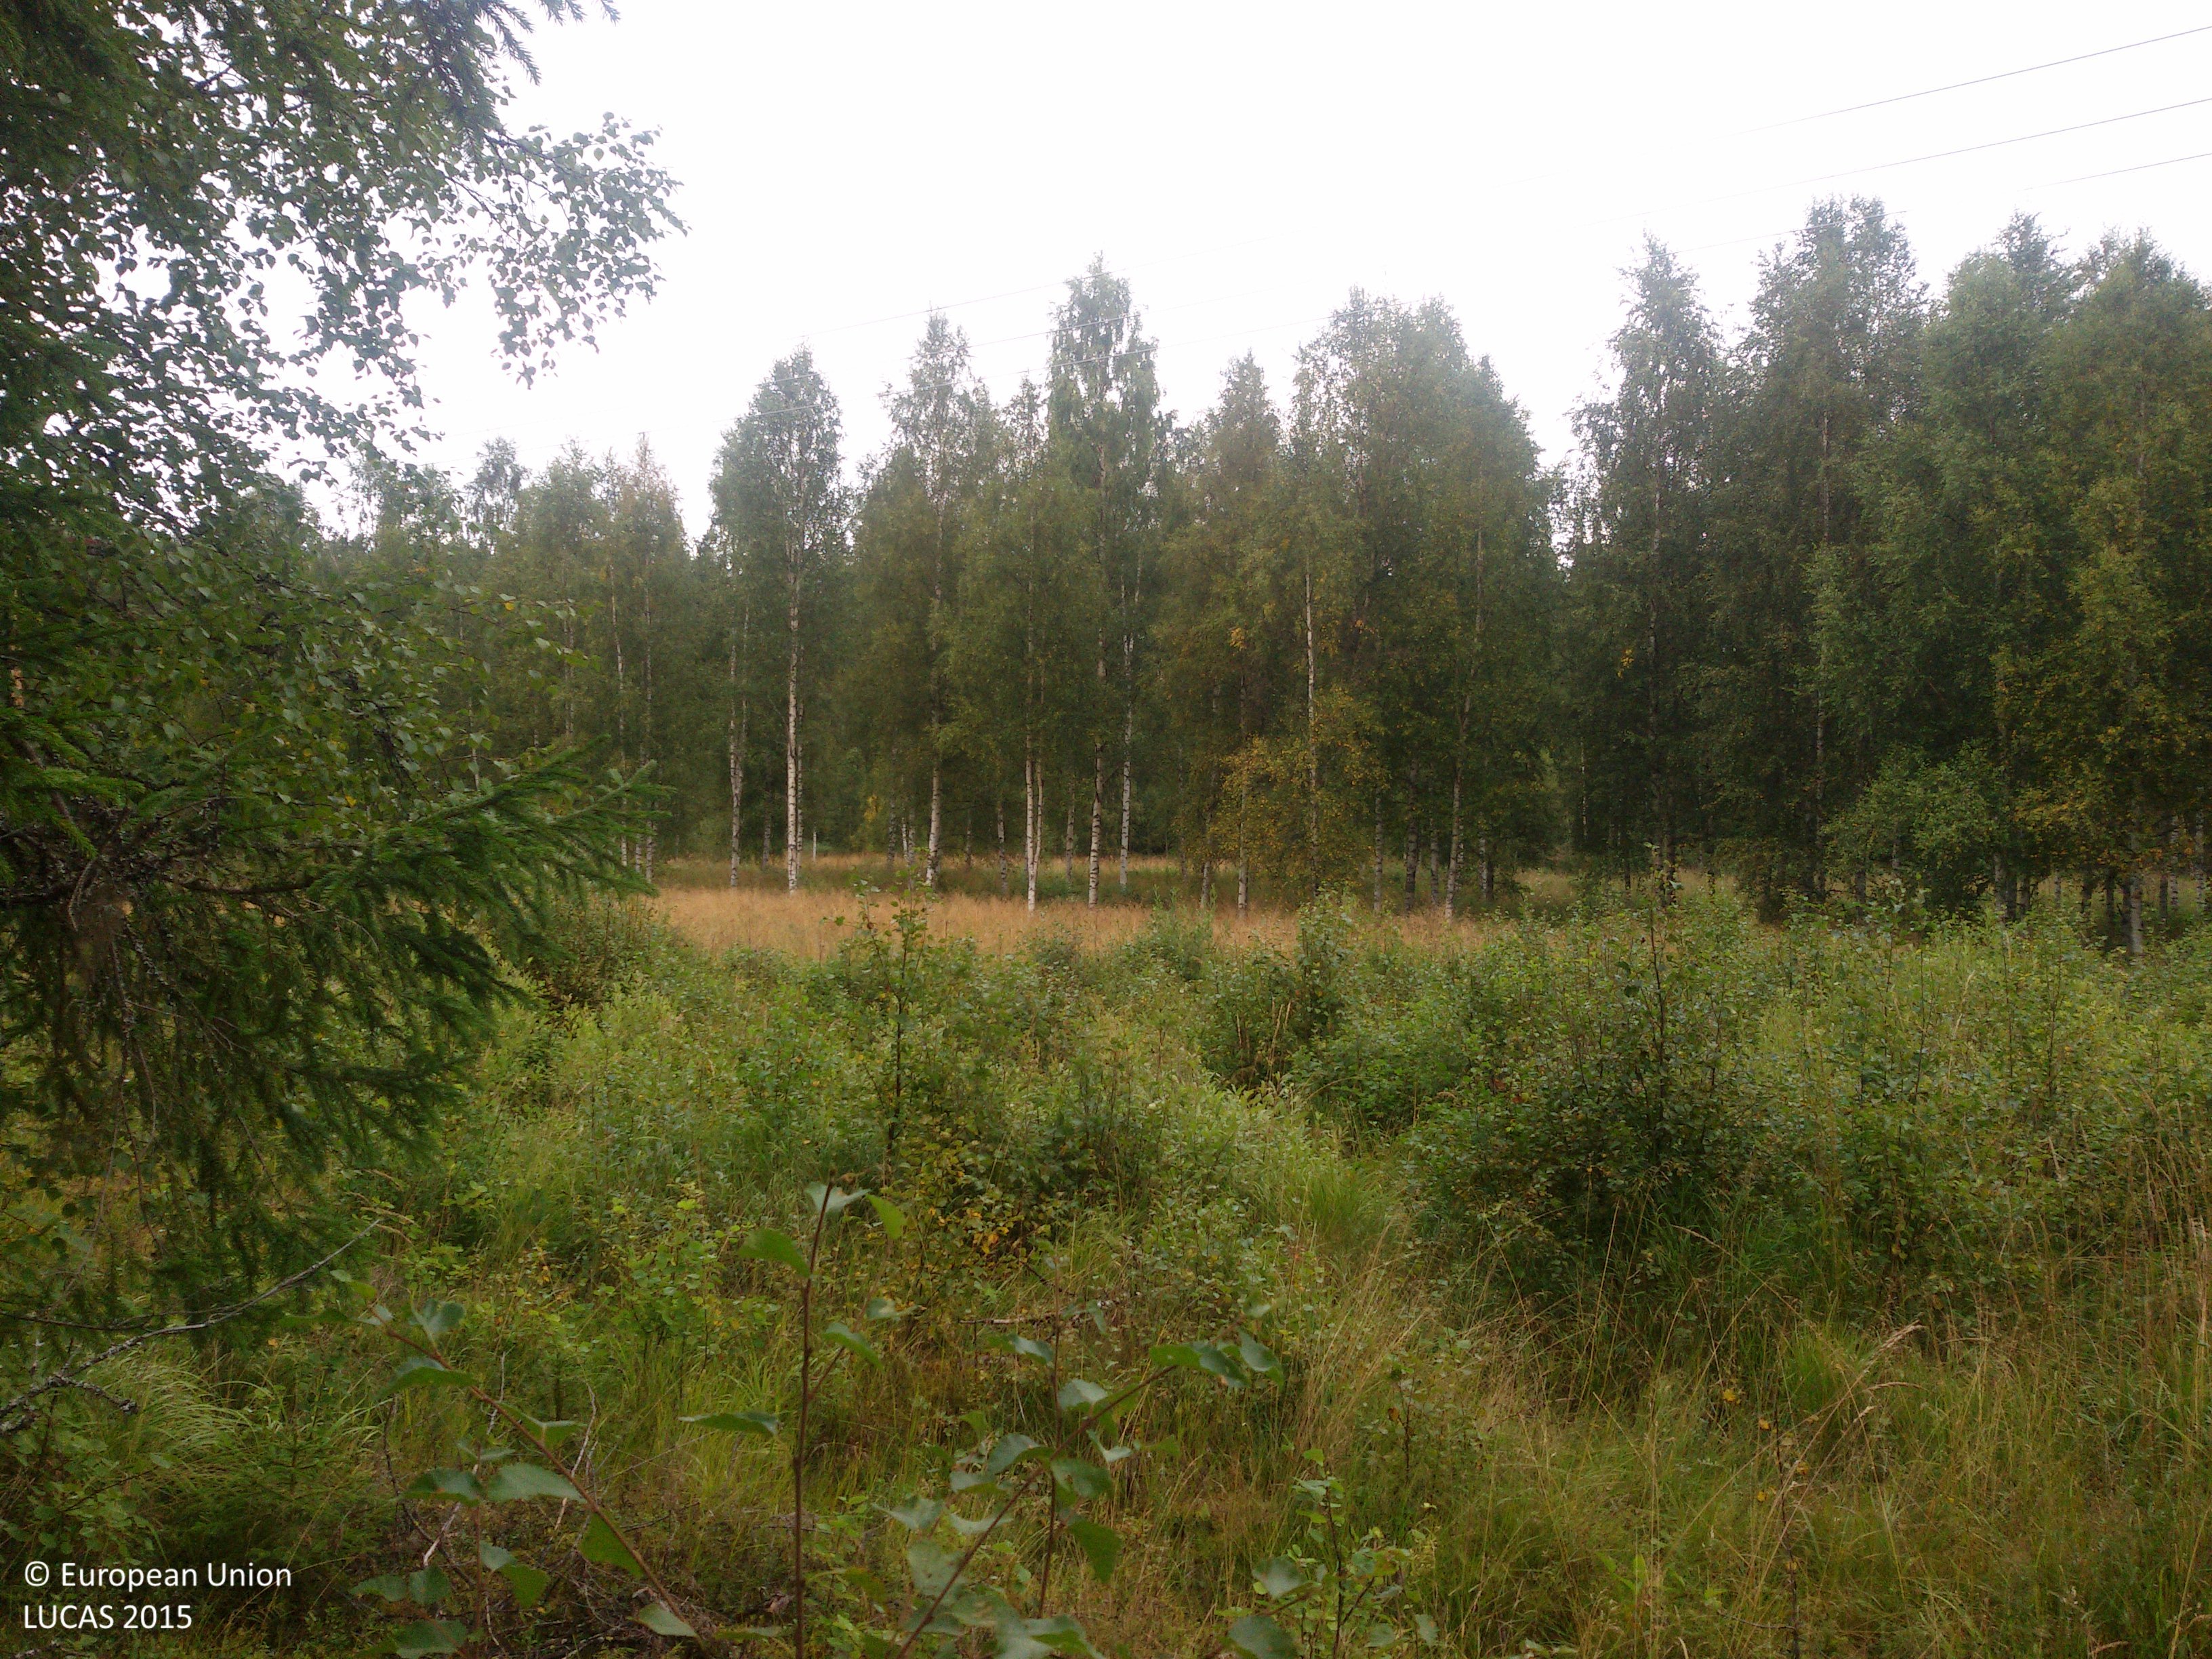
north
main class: Woodland
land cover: Spruce dominated mixed woodland
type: boreal forest
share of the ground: 50 - 75 %
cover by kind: coniferous forest trees 35 %, broadleaved forest trees 35 %, herbaceous plants 20 %, lichens and mosses 10 %
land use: Forestry
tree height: > 5 m
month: September
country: SE
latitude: 60.8193
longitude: 15.8151
